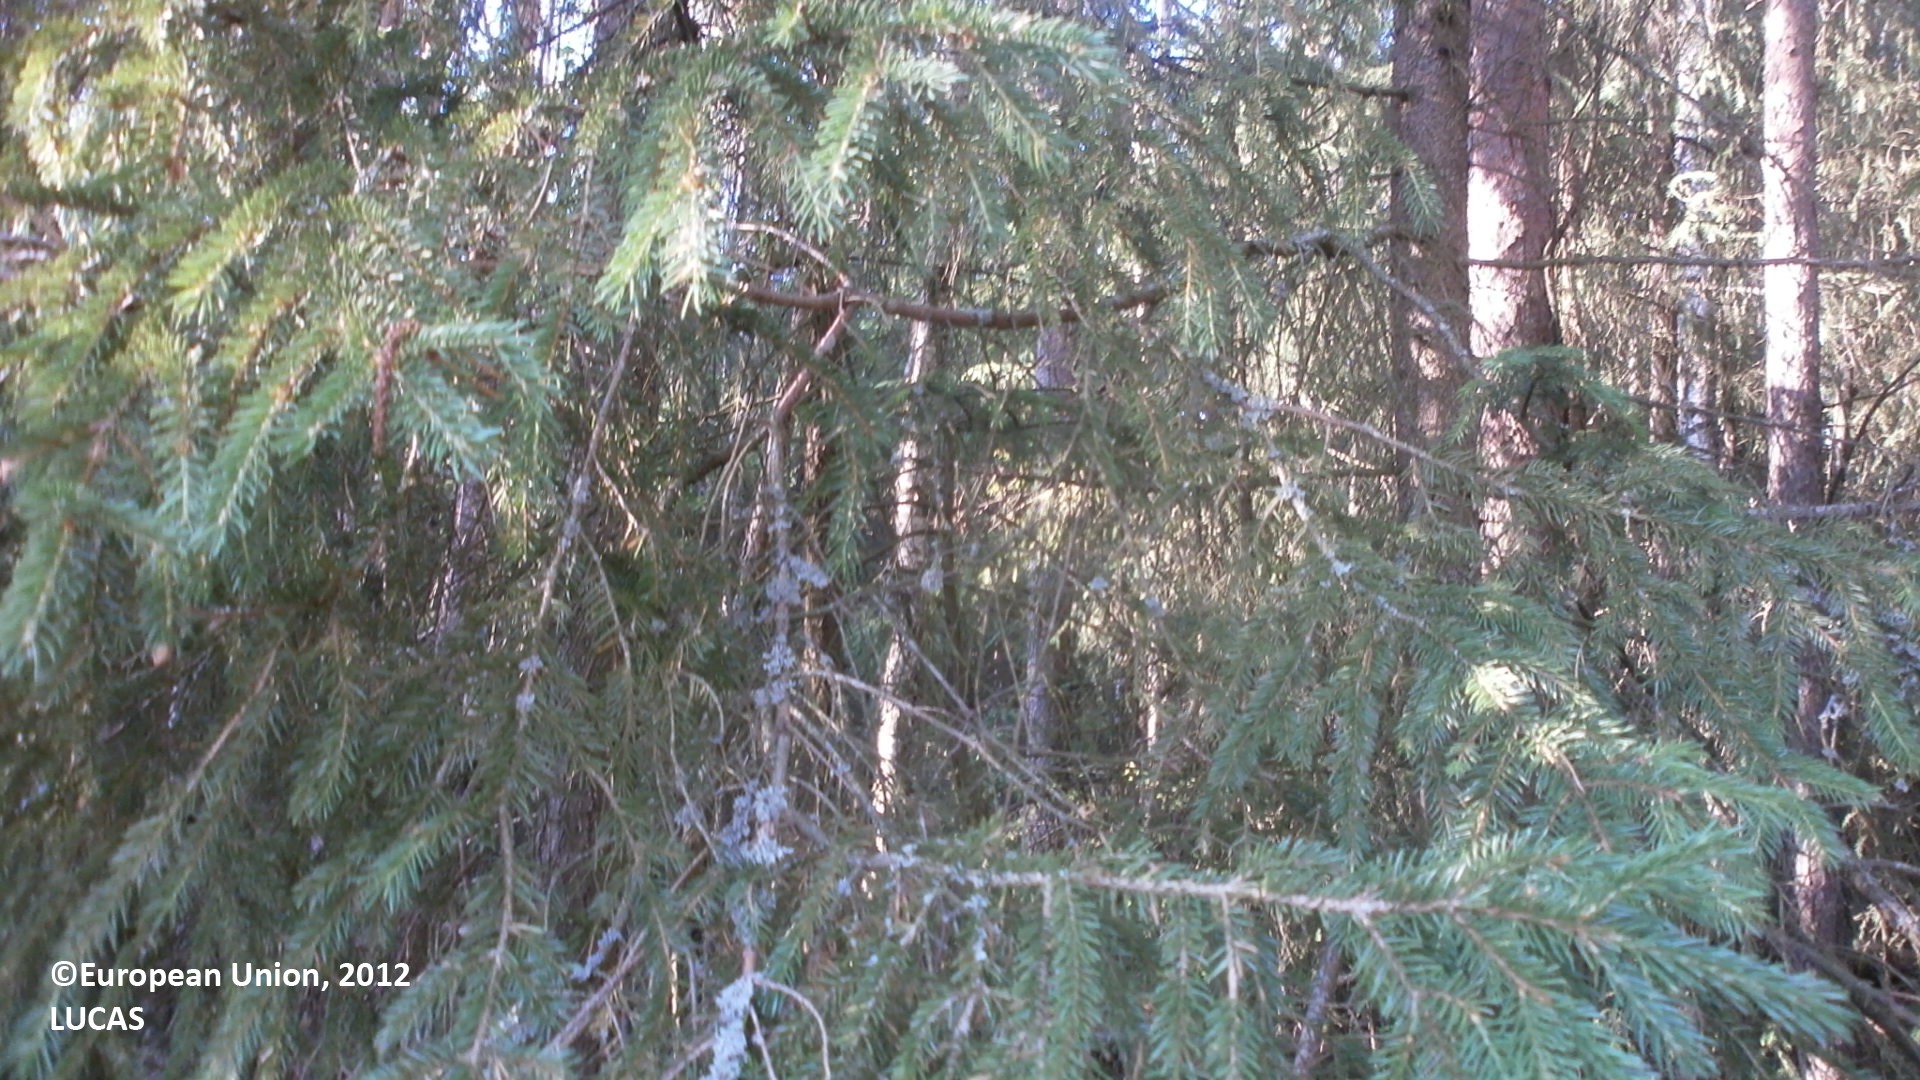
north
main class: Woodland
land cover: Spruce dominated mixed woodland
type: boreal forest
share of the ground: > 75 %
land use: Forestry
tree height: > 5 m
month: July
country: FI
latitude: 64.1156
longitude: 23.6704
